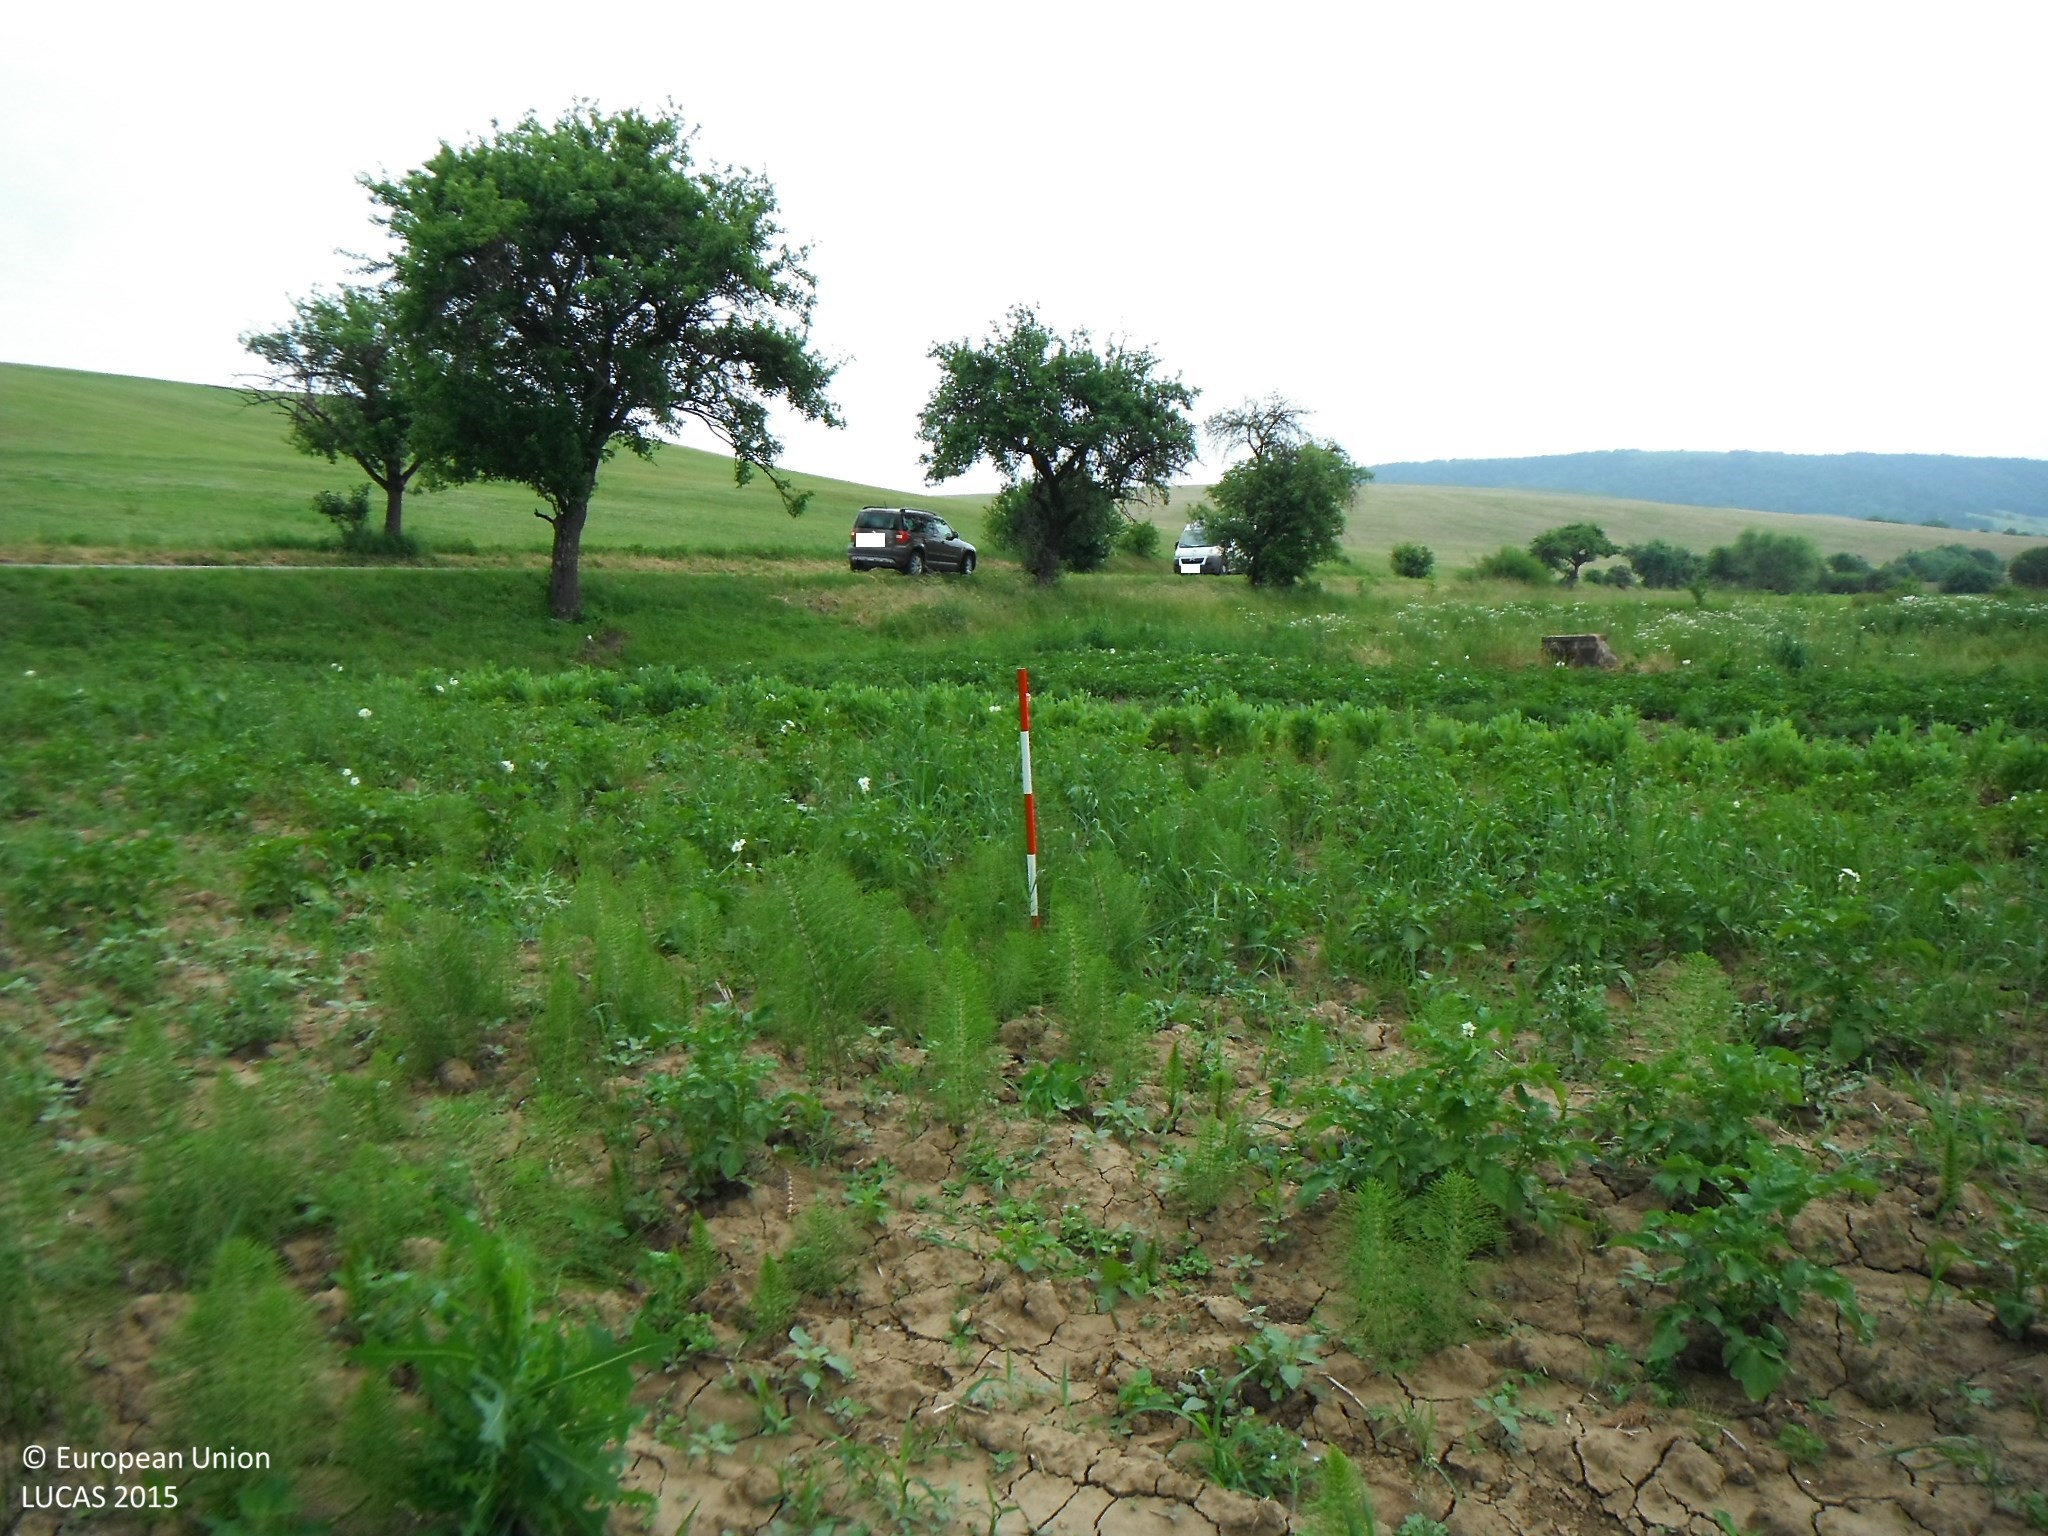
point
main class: Cropland
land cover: Potatoes
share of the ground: 25 - 50 %
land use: Kitchen garden
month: June
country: SK
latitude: 49.1398
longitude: 21.3831
